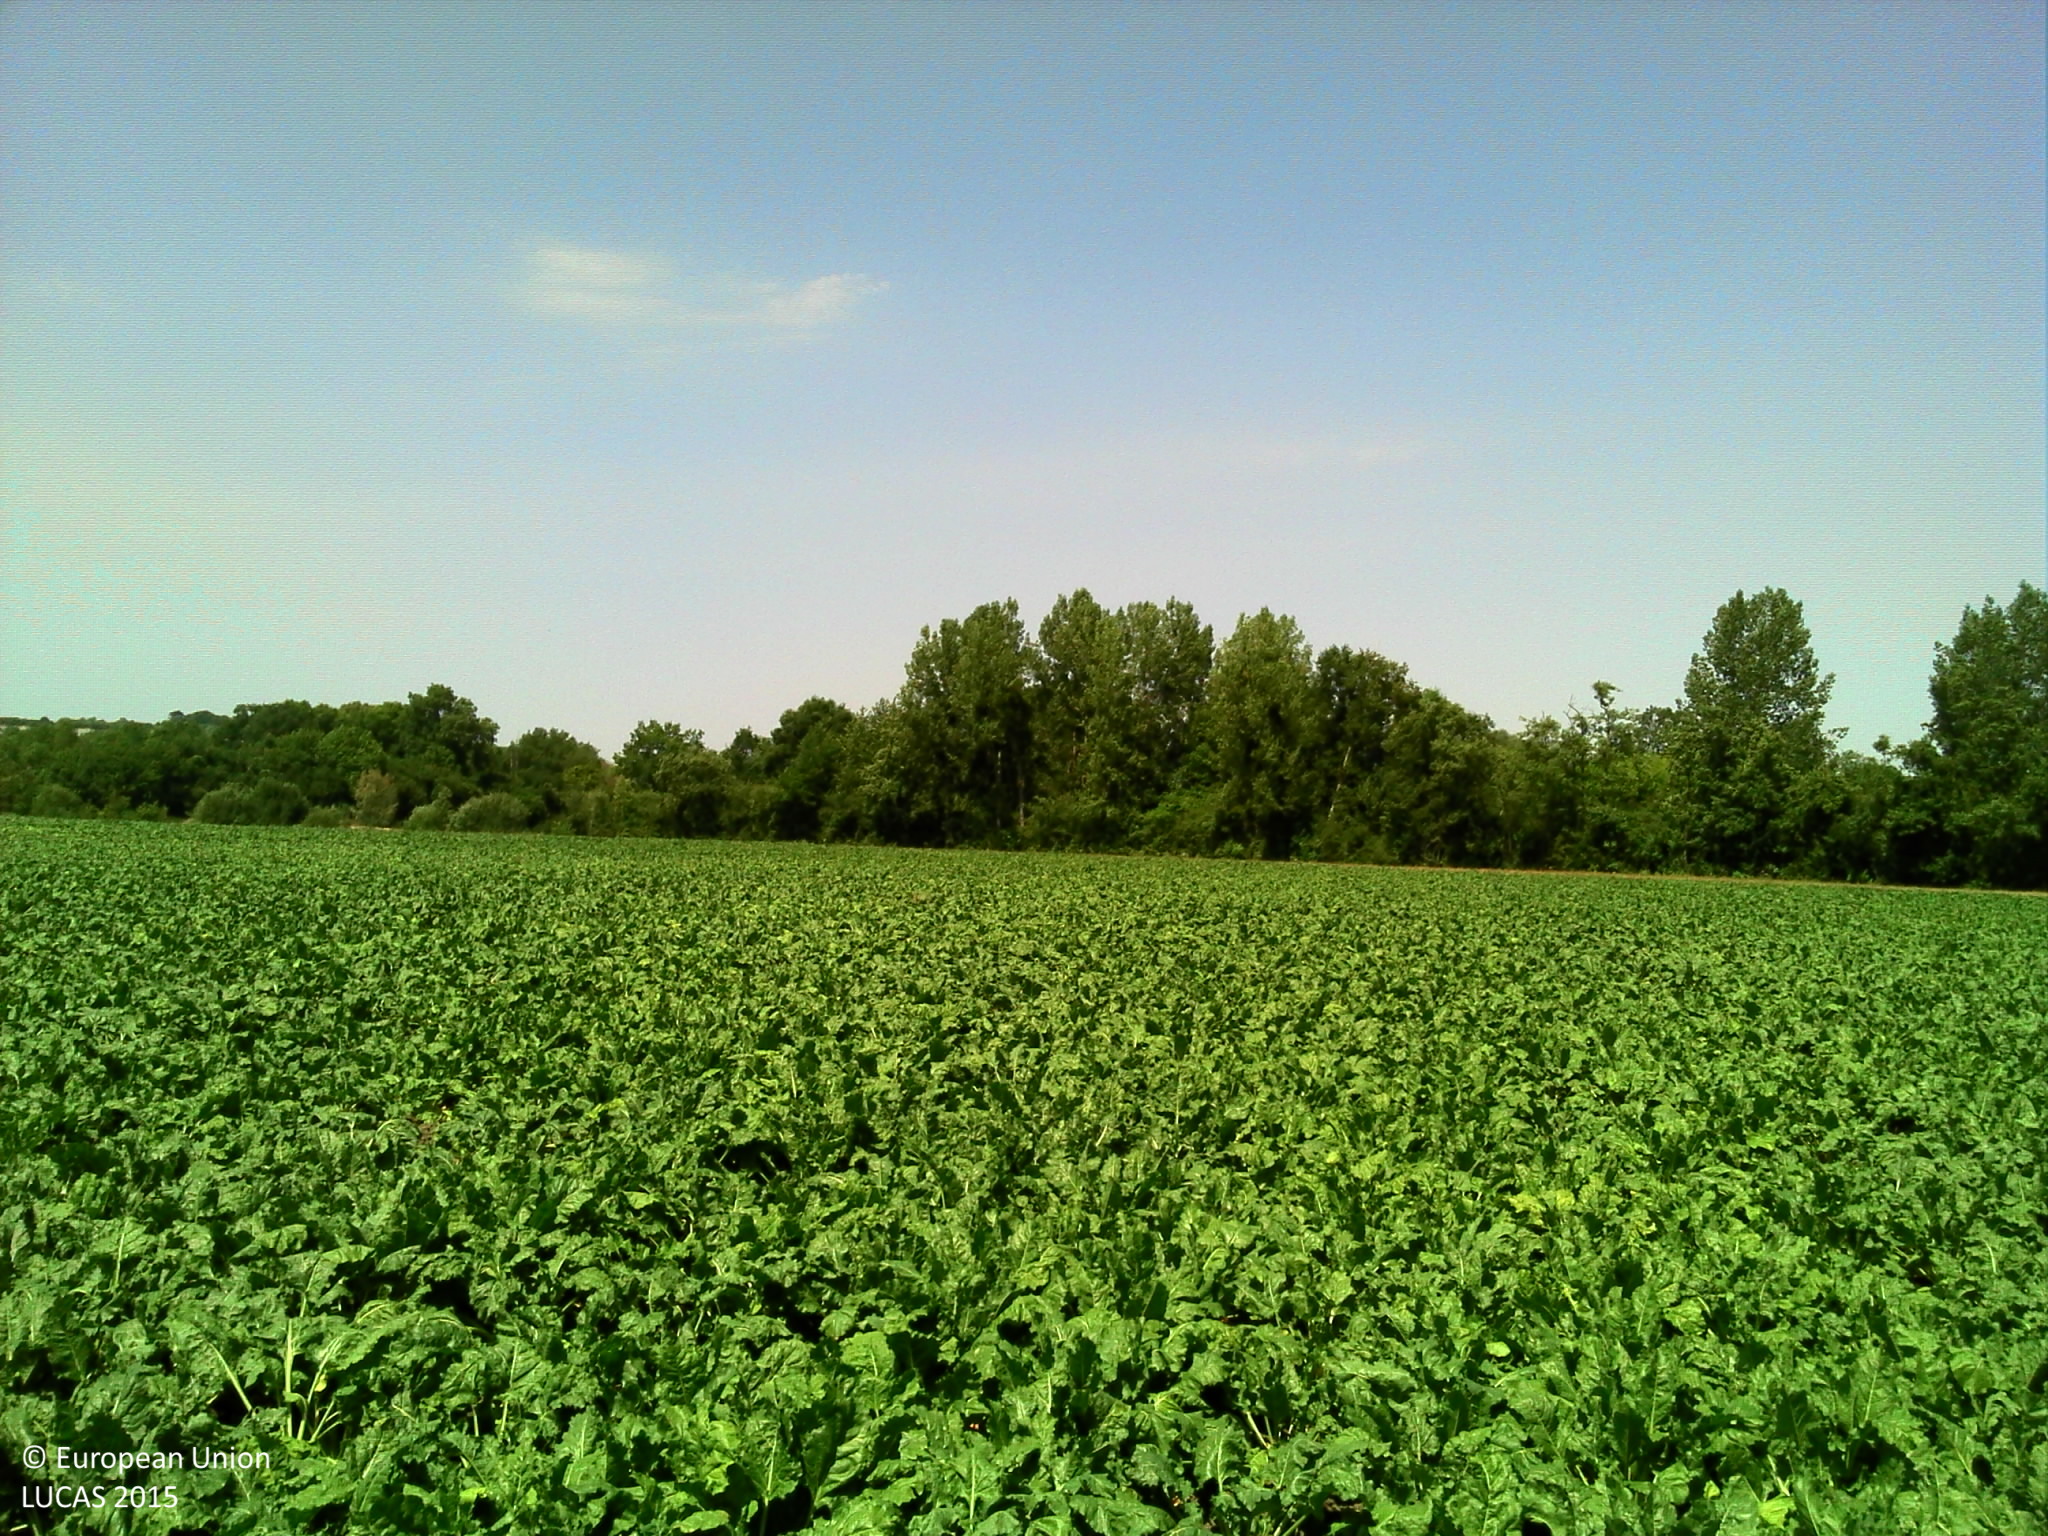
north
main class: Cropland
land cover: Sugar beet
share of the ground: > 75 %
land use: Agriculture (excluding fallow land and kitchen gardens)
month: July
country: FR
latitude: 49.1879
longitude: 2.3726
